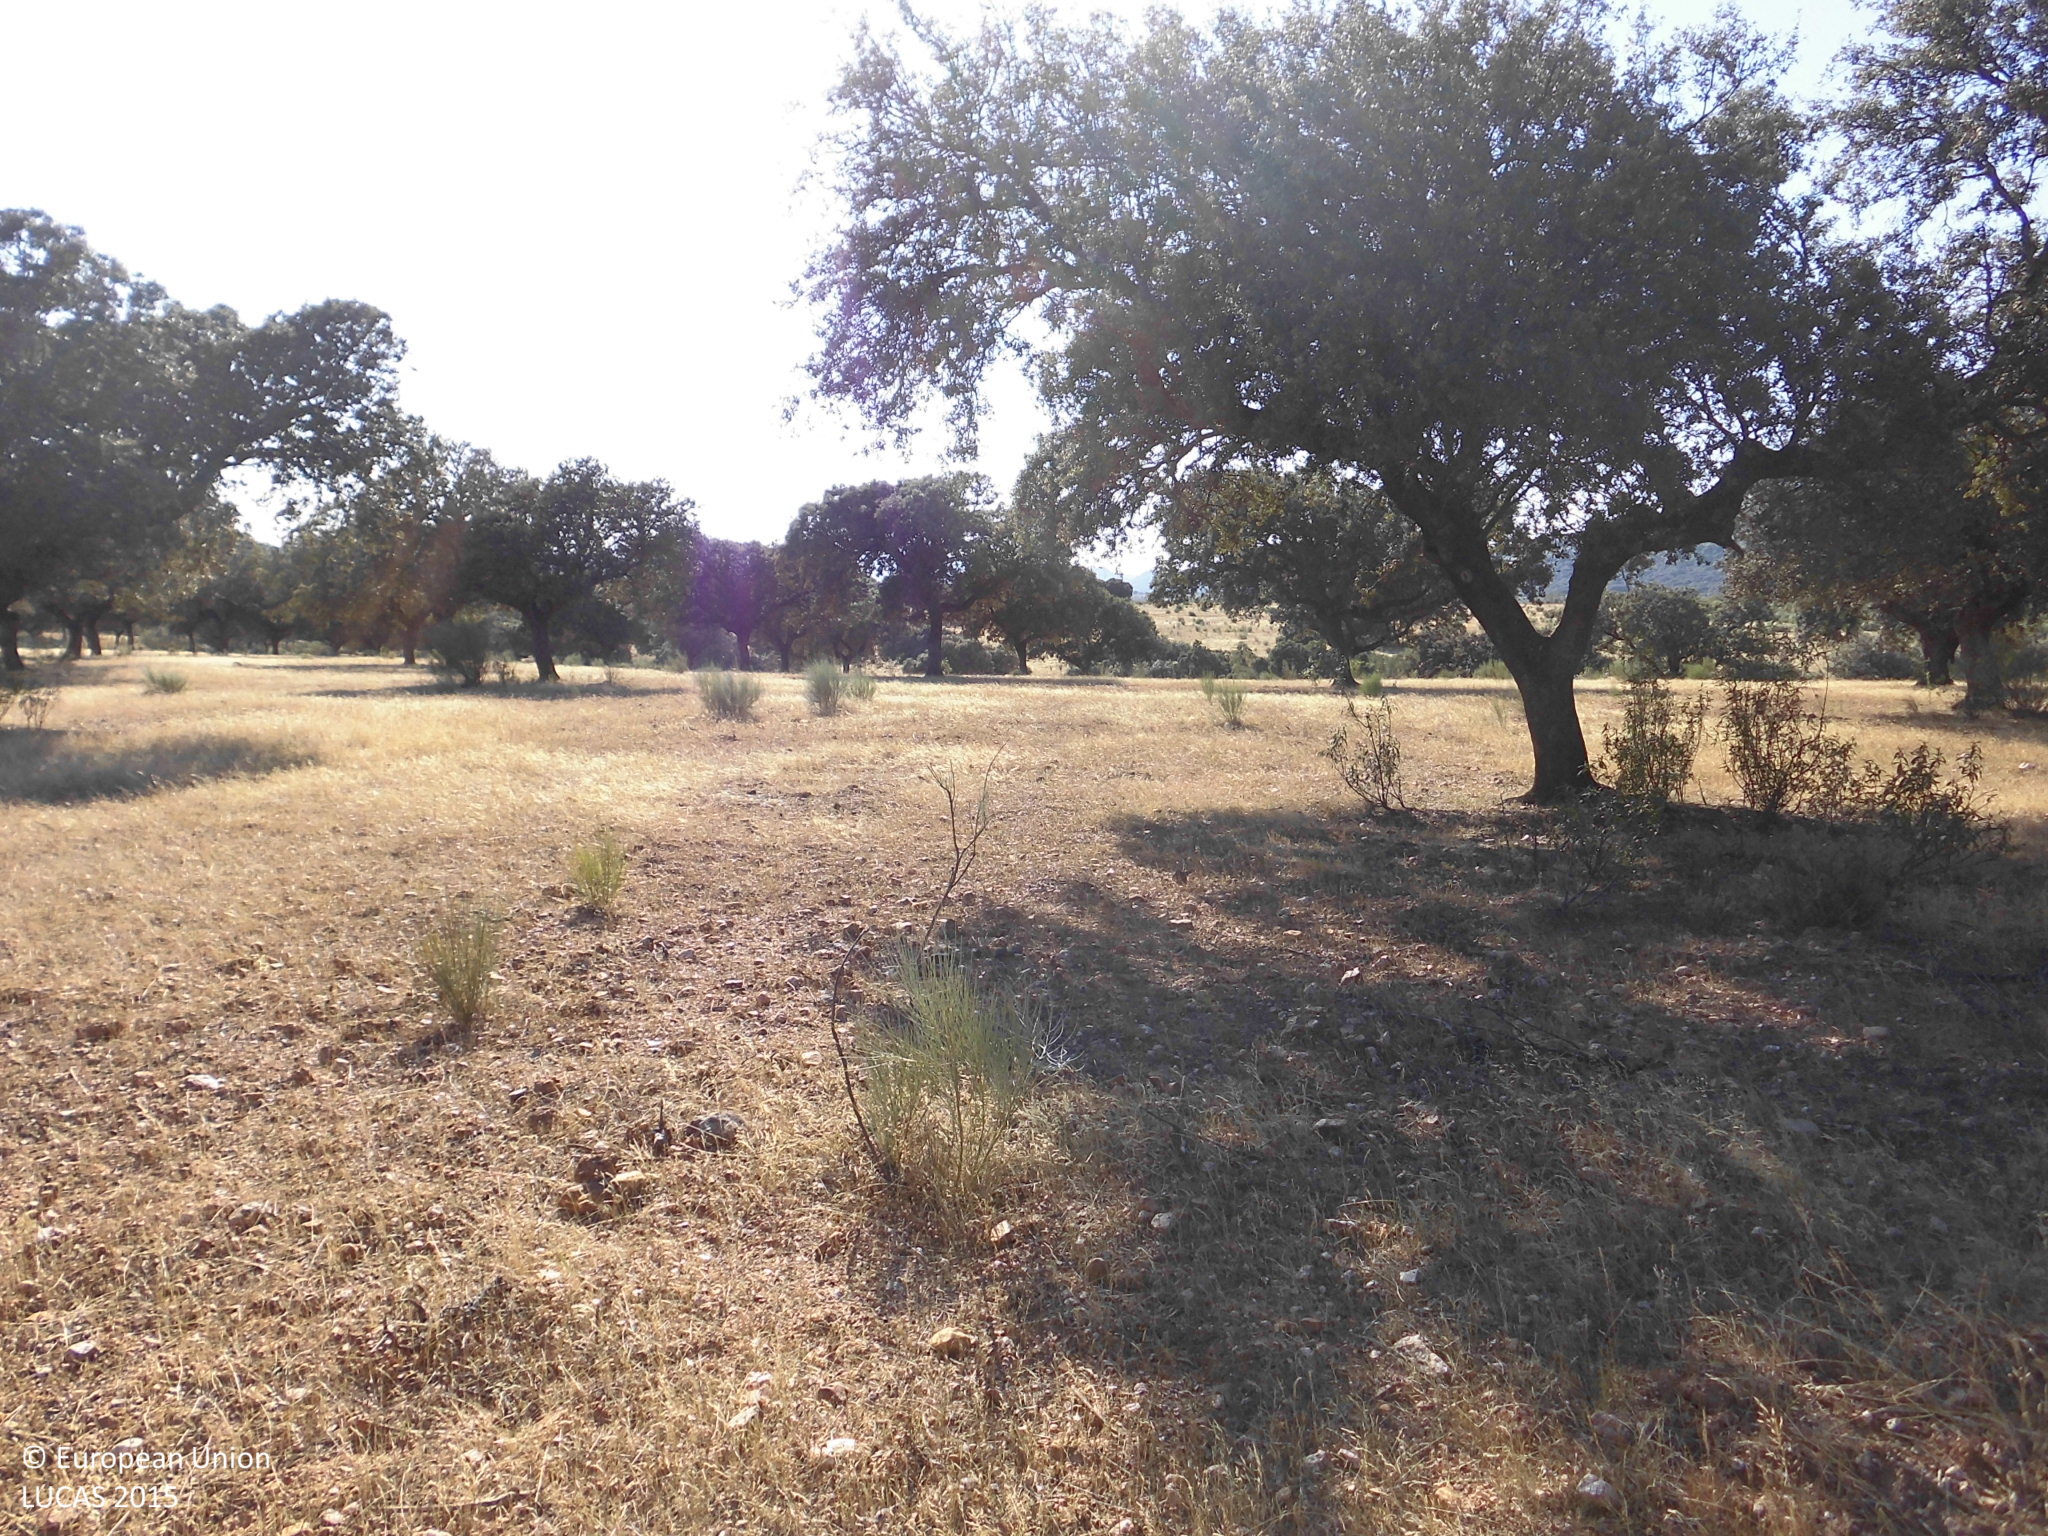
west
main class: Woodland
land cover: Broadleaved woodland
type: broadleaved evergreen forest
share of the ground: 10 - 25 %
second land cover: Grassland without tree/shrub cover
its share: > 75 %
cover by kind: herbaceous plants 75 %, broadleaved forest trees 25 %
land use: Forestry
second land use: Agriculture (excluding fallow land and kitchen gardens)
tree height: > 5 m
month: June
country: ES
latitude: 39.7977
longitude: -5.9602
